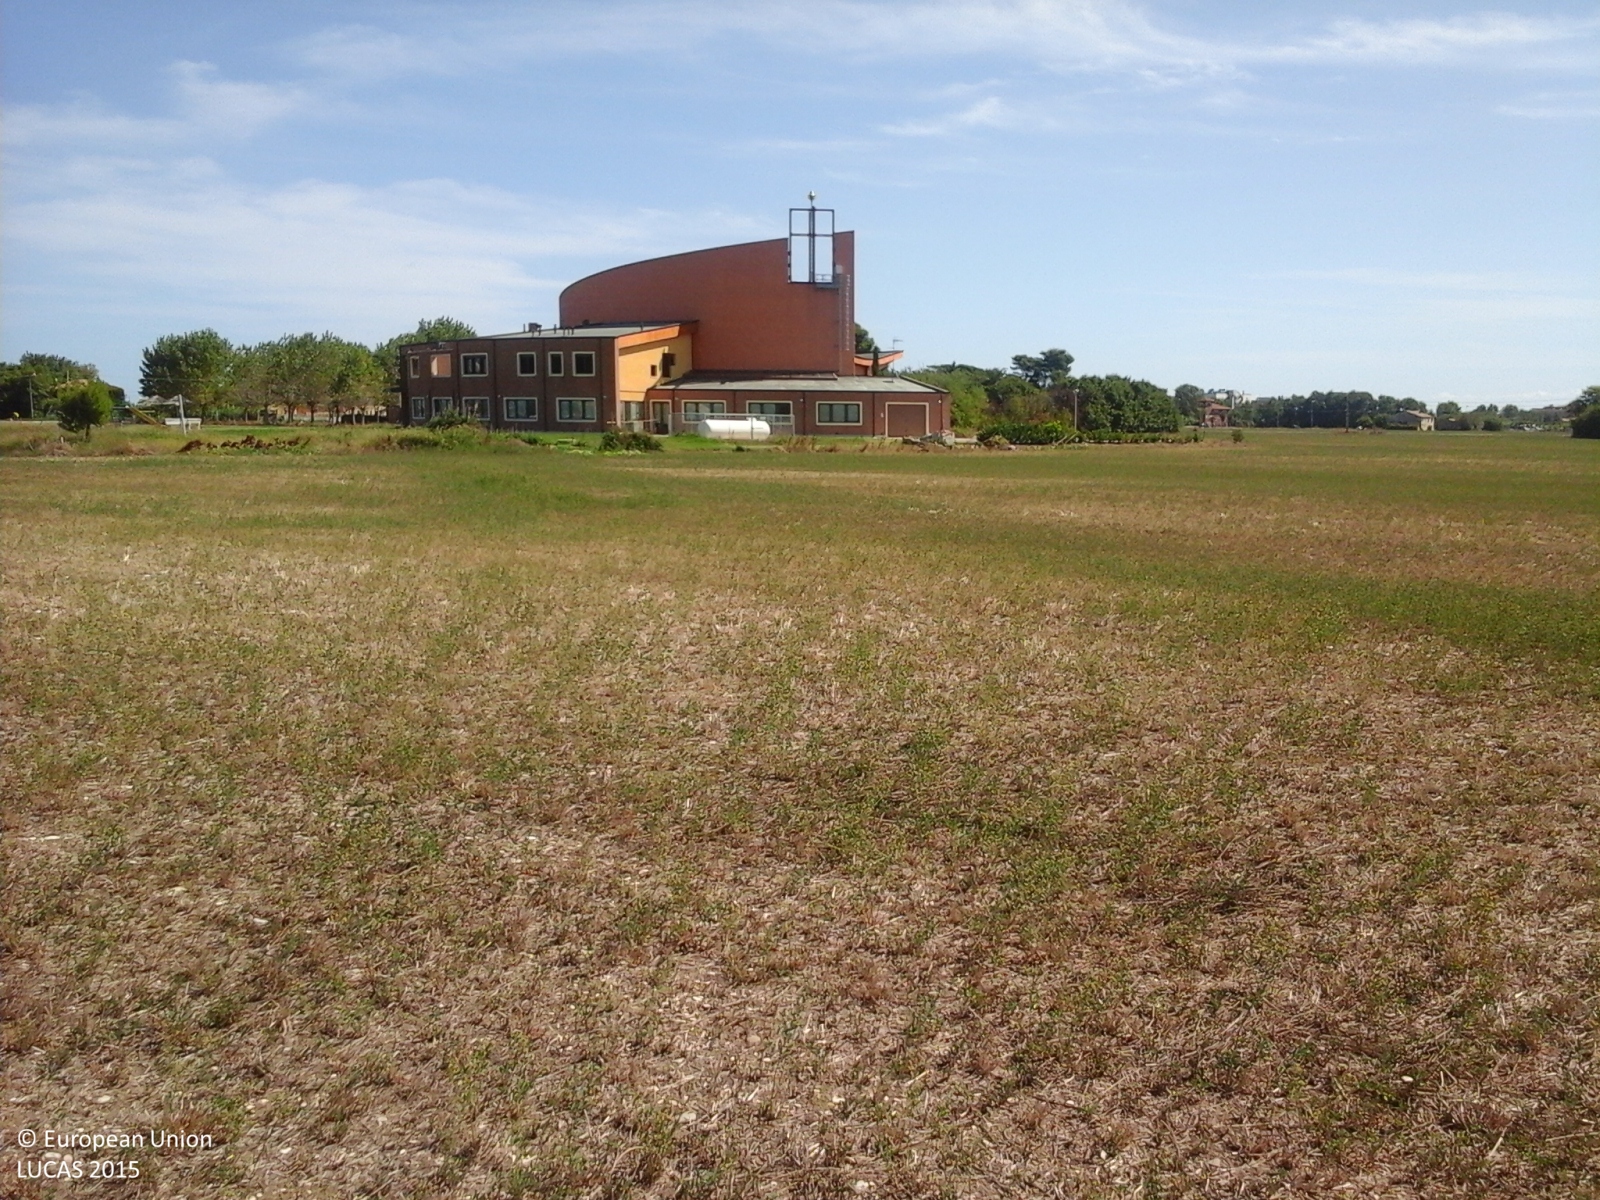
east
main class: Cropland
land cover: Lucerne
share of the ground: > 75 %
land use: Agriculture (excluding fallow land and kitchen gardens)
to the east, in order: Lucerne; Grassland without tree/shrub cover; Artificial constructions in urban areas; Lucerne; Grassland without tree/shrub cover; Broadleaved woodland; Artificial constructions in urban areas; Broadleaved woodland
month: September
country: IT
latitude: 43.7992
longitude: 13.0876
